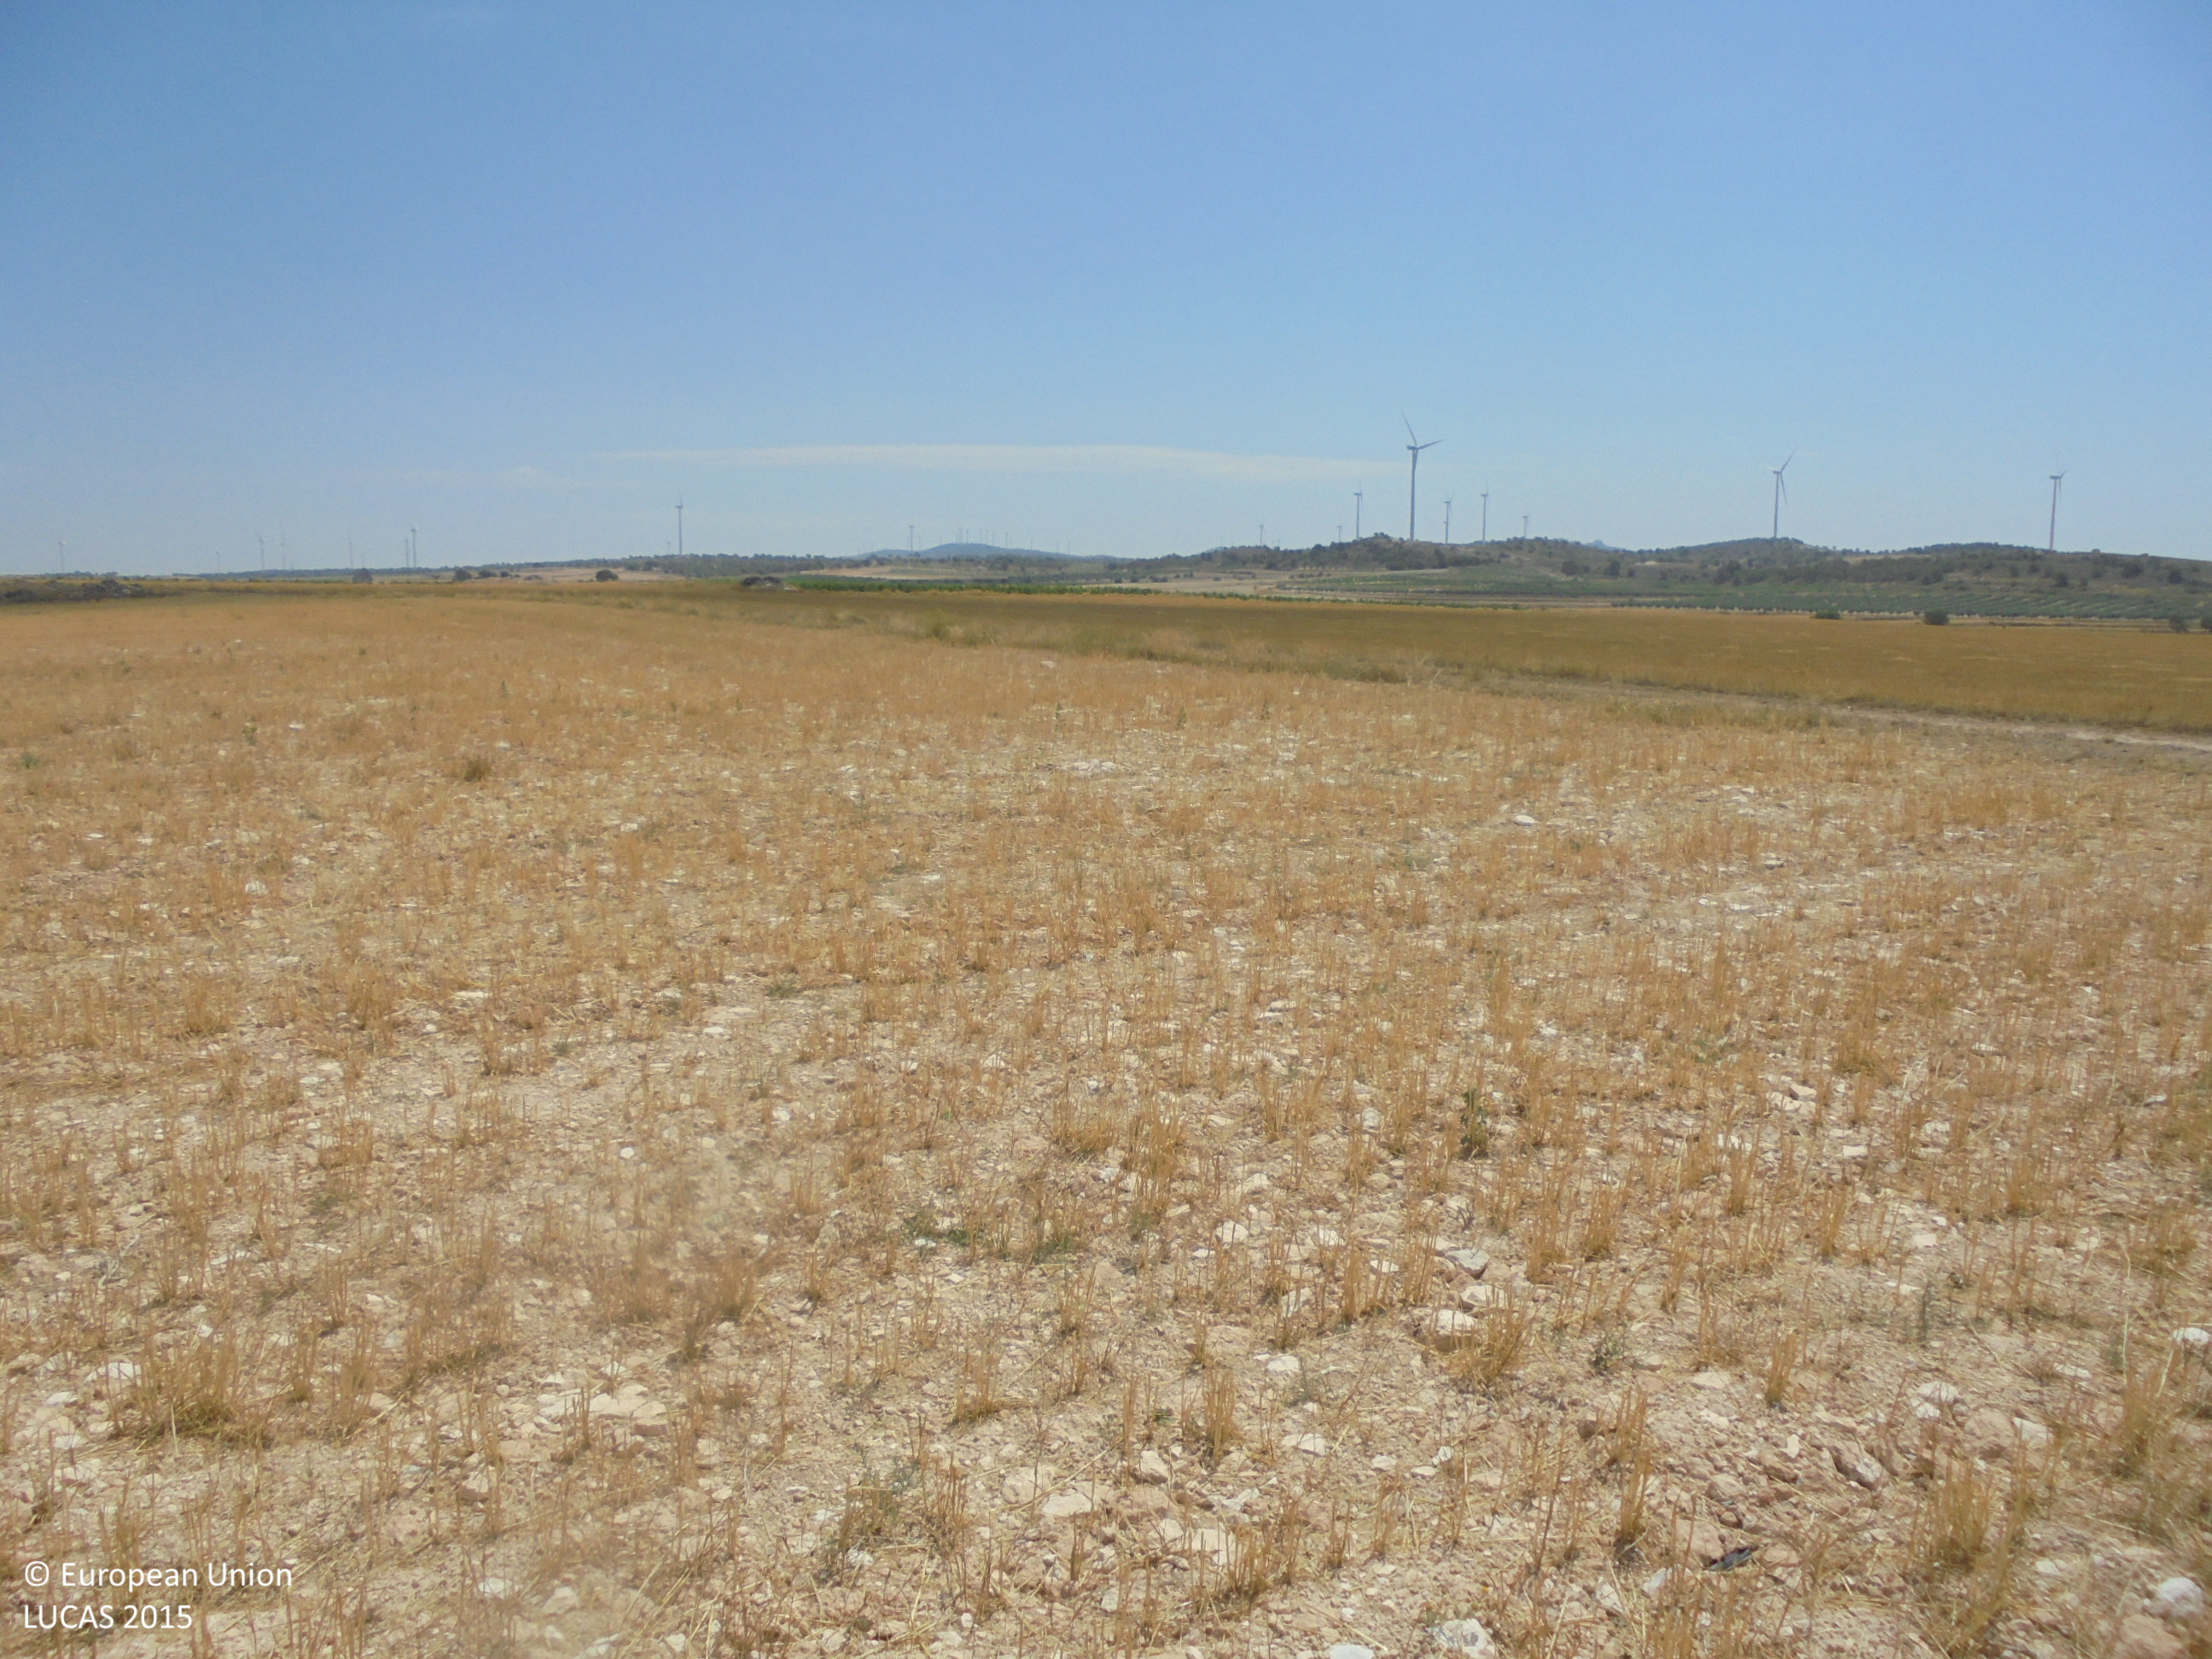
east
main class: Cropland
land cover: Barley
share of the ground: < 10 %
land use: Agriculture (excluding fallow land and kitchen gardens)
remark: Harvested field
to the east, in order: Barley; Grass margins; Tracks; Grass margins; Barley; Grass margins; Vineyards
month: July
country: ES
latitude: 38.5966
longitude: -1.3940
